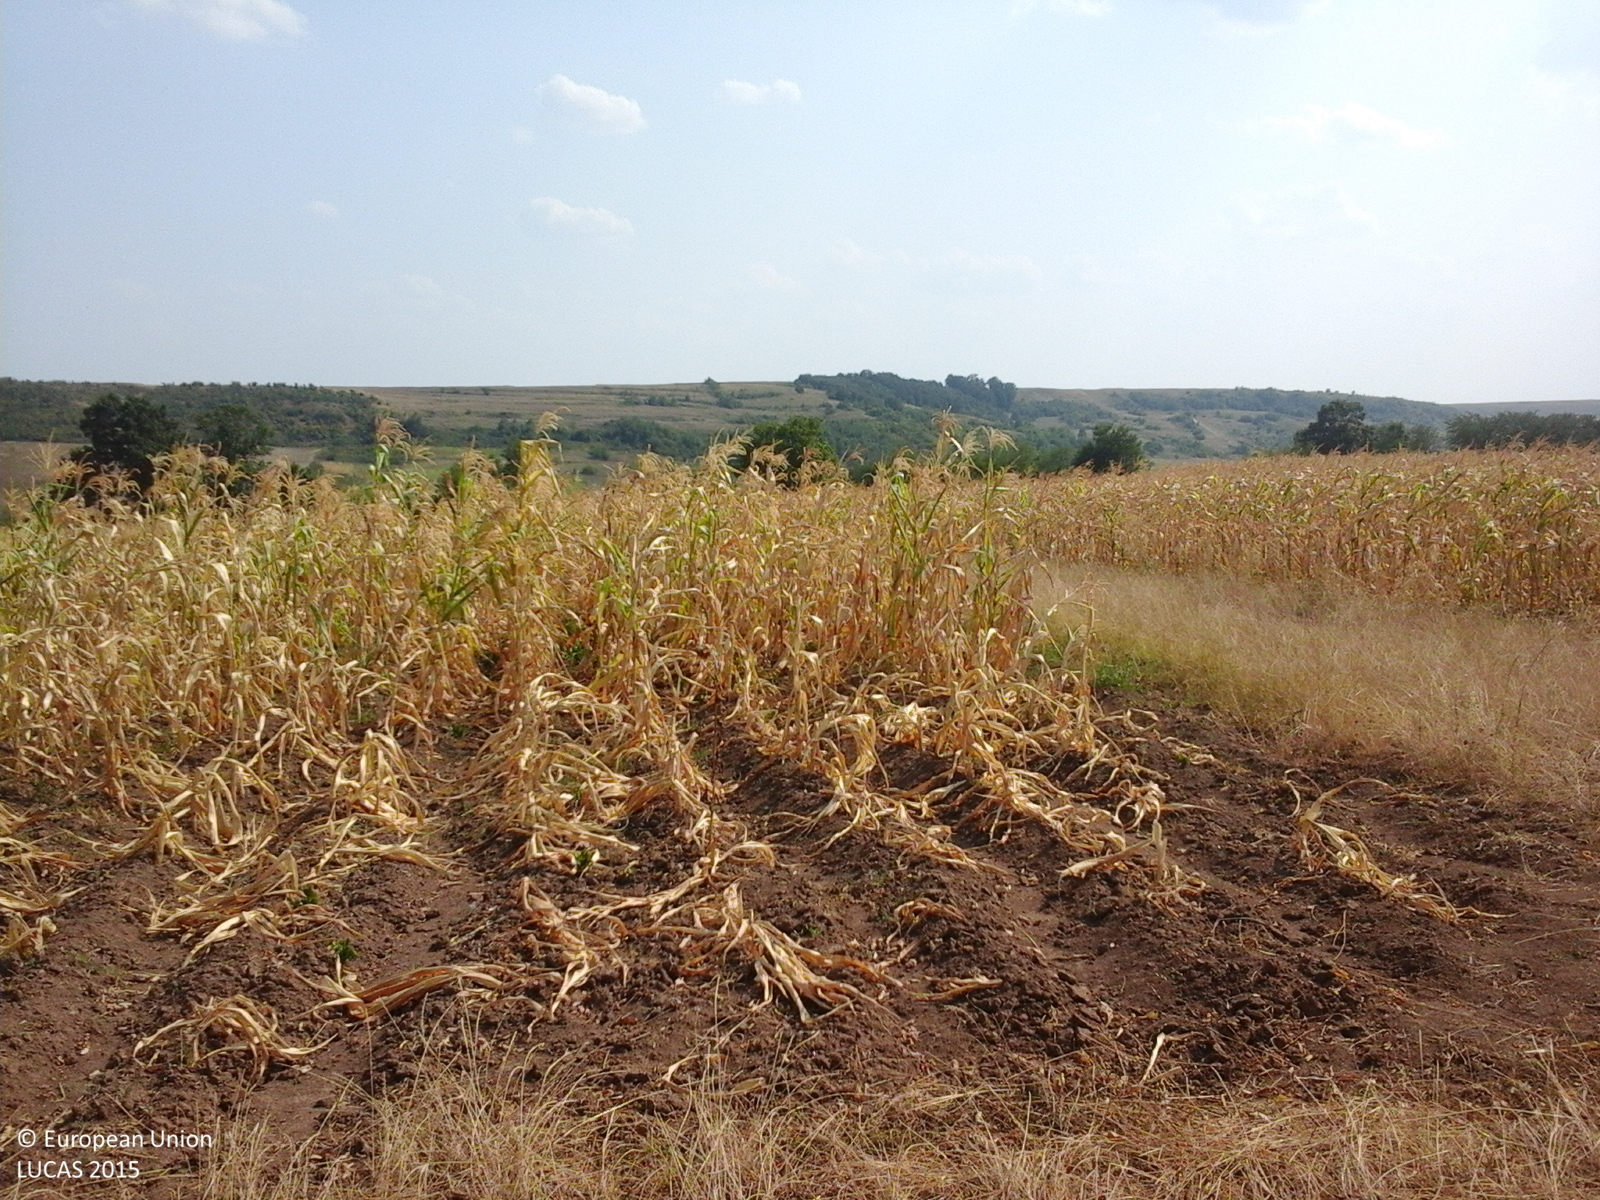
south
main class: Shrubland
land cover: Shrubland with sparse tree cover
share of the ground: > 75 %
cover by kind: shrubs 95 %, broadleaved forest trees 5 %
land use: Semi-natural and natural areas not in use
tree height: > 5 m
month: August
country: RO
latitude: 44.3680
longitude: 23.5683
